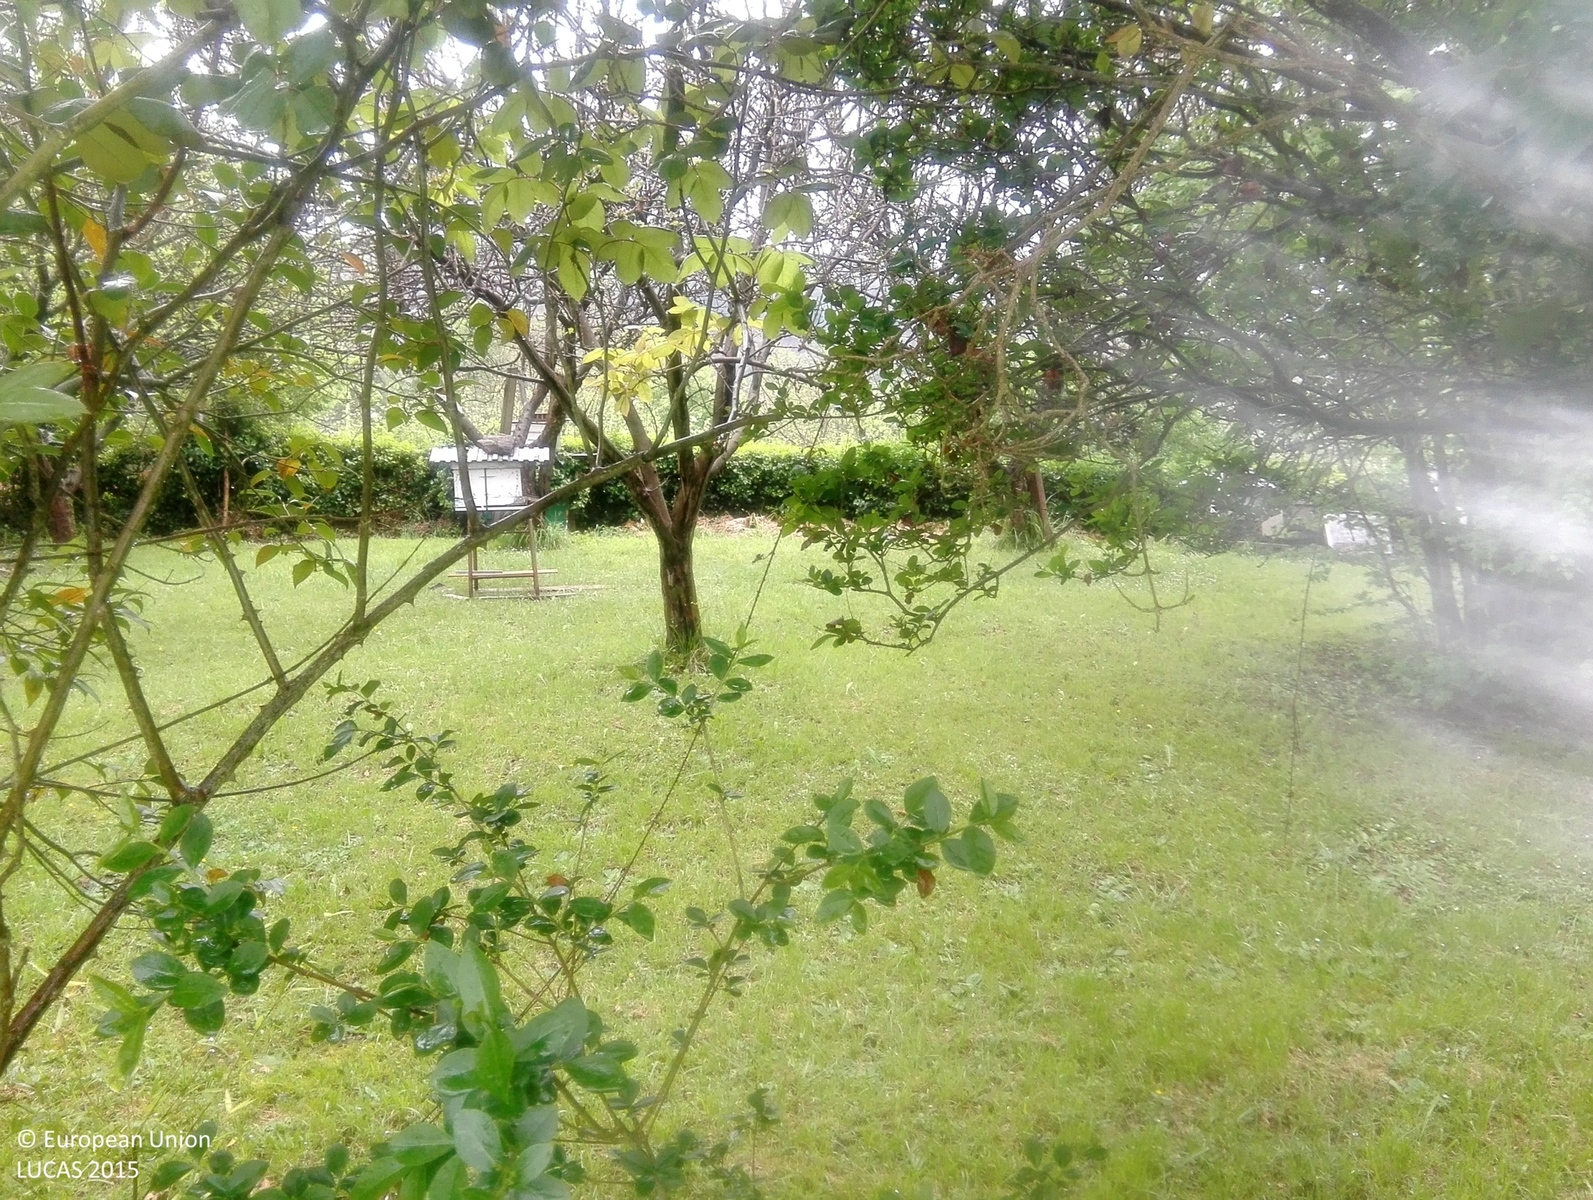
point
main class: Cropland
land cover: Apple fruit
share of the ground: 50 - 75 %
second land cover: Grassland without tree/shrub cover
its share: > 75 %
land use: Kitchen garden
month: April
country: ES
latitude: 43.3472
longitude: -5.9419
